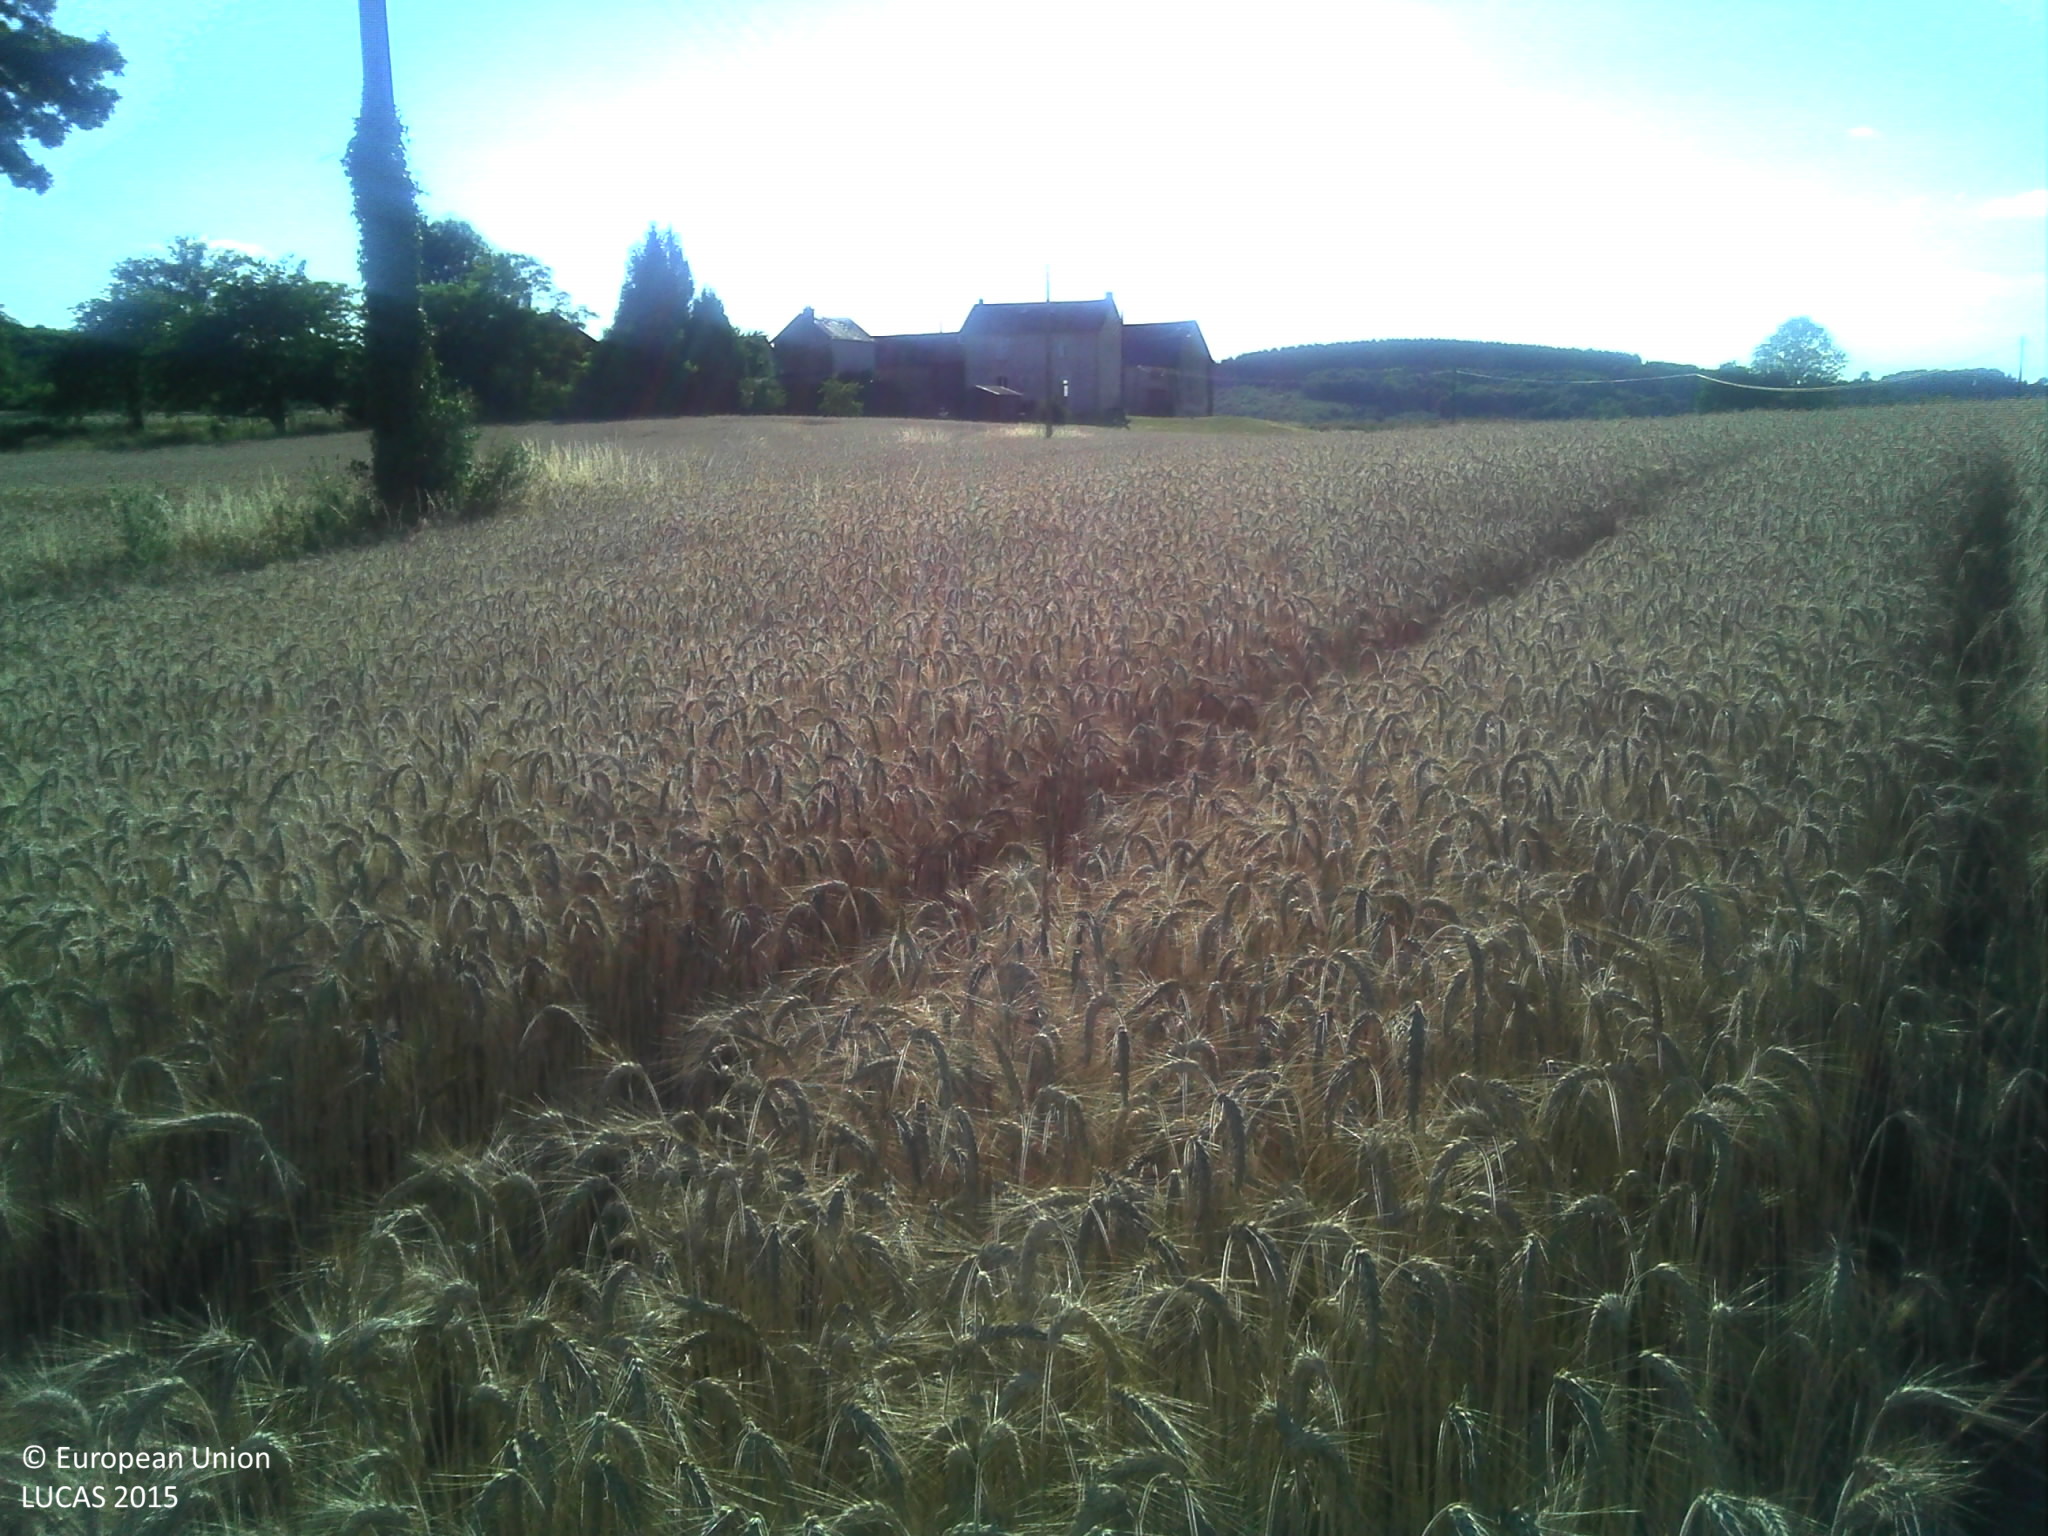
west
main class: Cropland
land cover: Common wheat
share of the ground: > 75 %
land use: Agriculture (excluding fallow land and kitchen gardens)
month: July
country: FR
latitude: 46.2357
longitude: 1.5752
